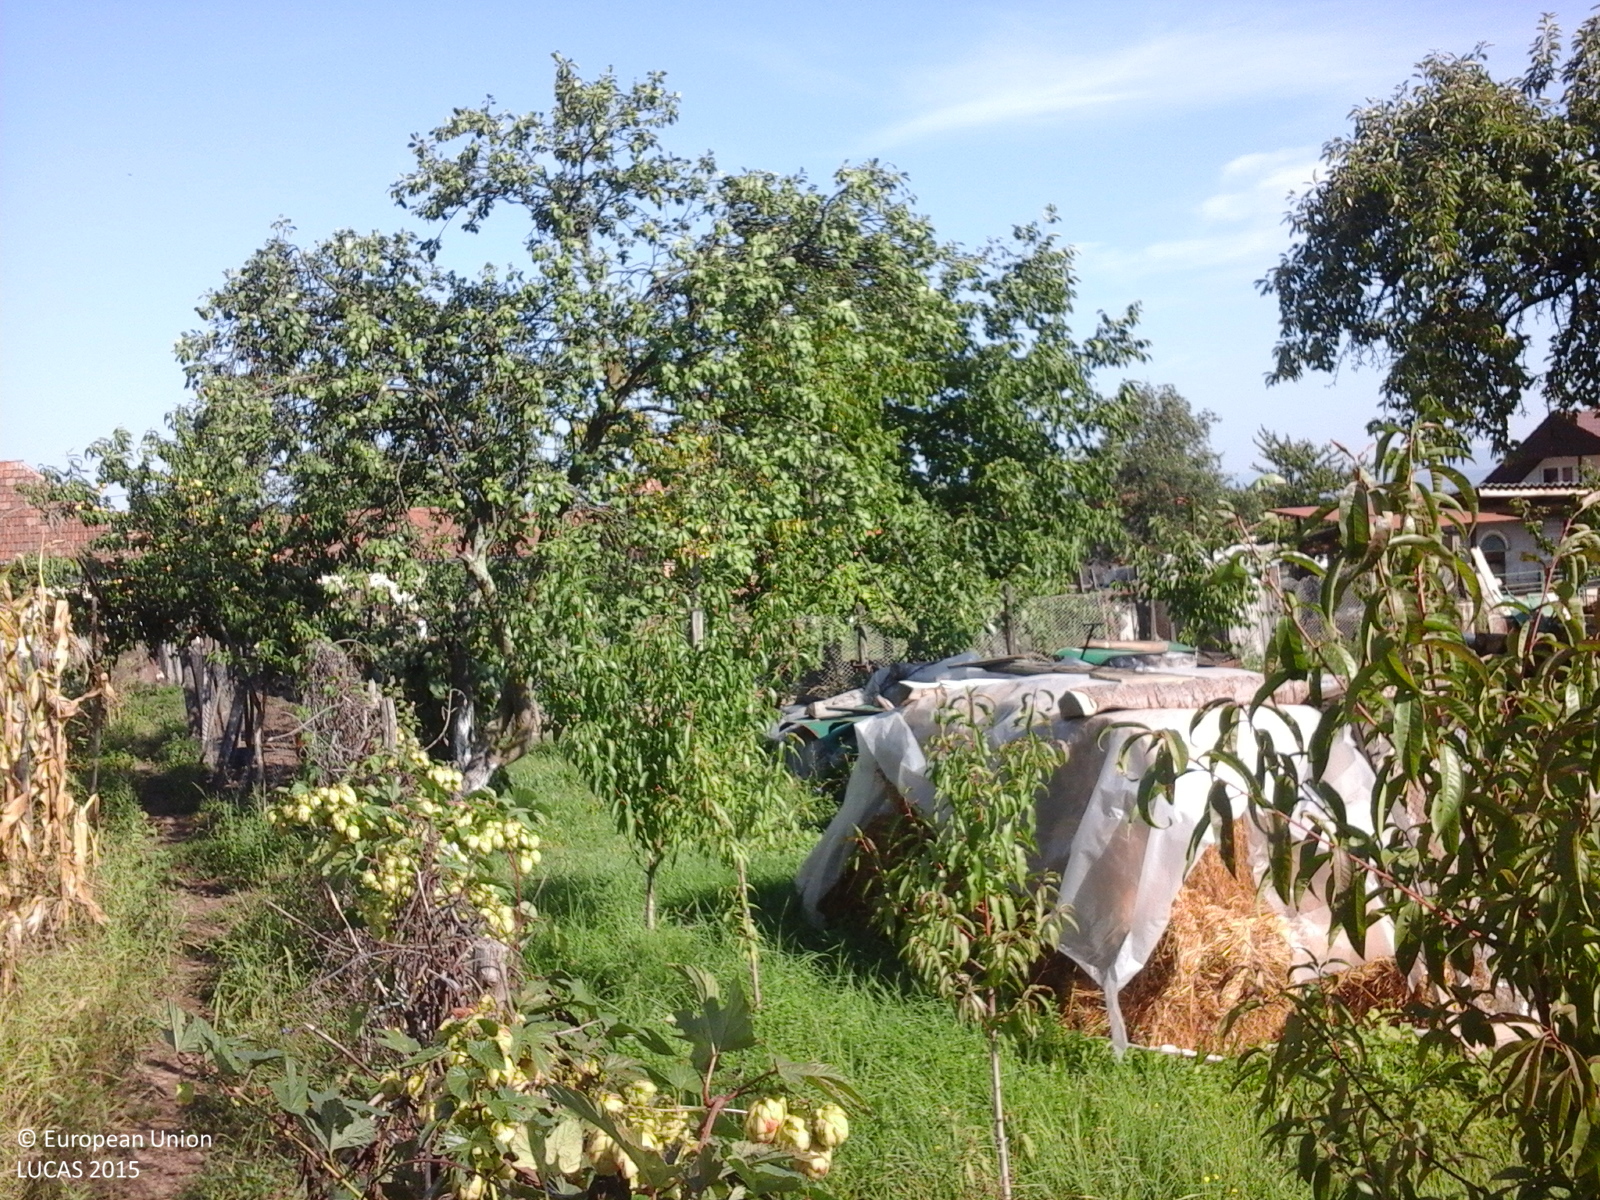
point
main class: Cropland
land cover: Other fruit trees and berries
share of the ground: > 75 %
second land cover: Grassland without tree/shrub cover
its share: > 75 %
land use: Kitchen garden
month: September
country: RO
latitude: 46.5520
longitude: 22.4282
